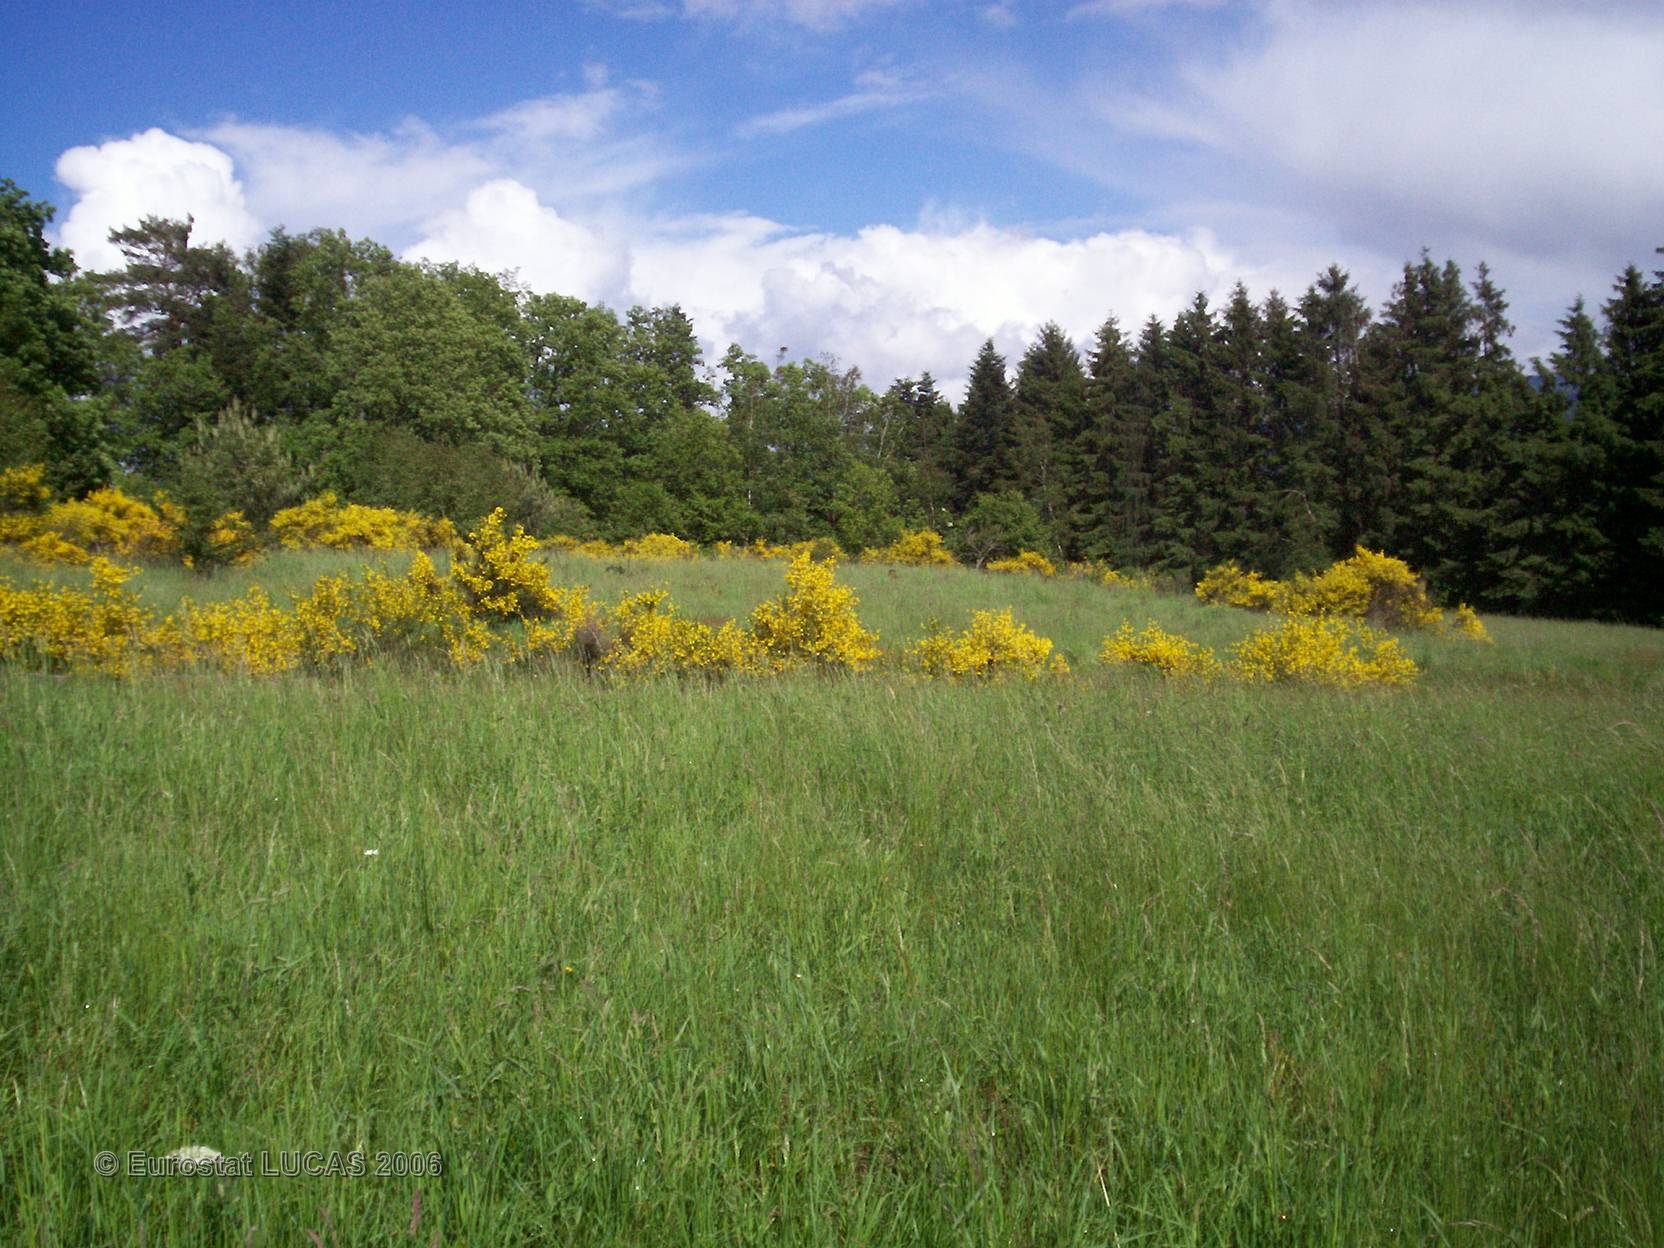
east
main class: Grassland
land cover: Grassland without tree/shrub cover
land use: Agriculture (excluding fallow land and kitchen gardens)
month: May
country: FR
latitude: 48.2921
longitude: 7.0491
